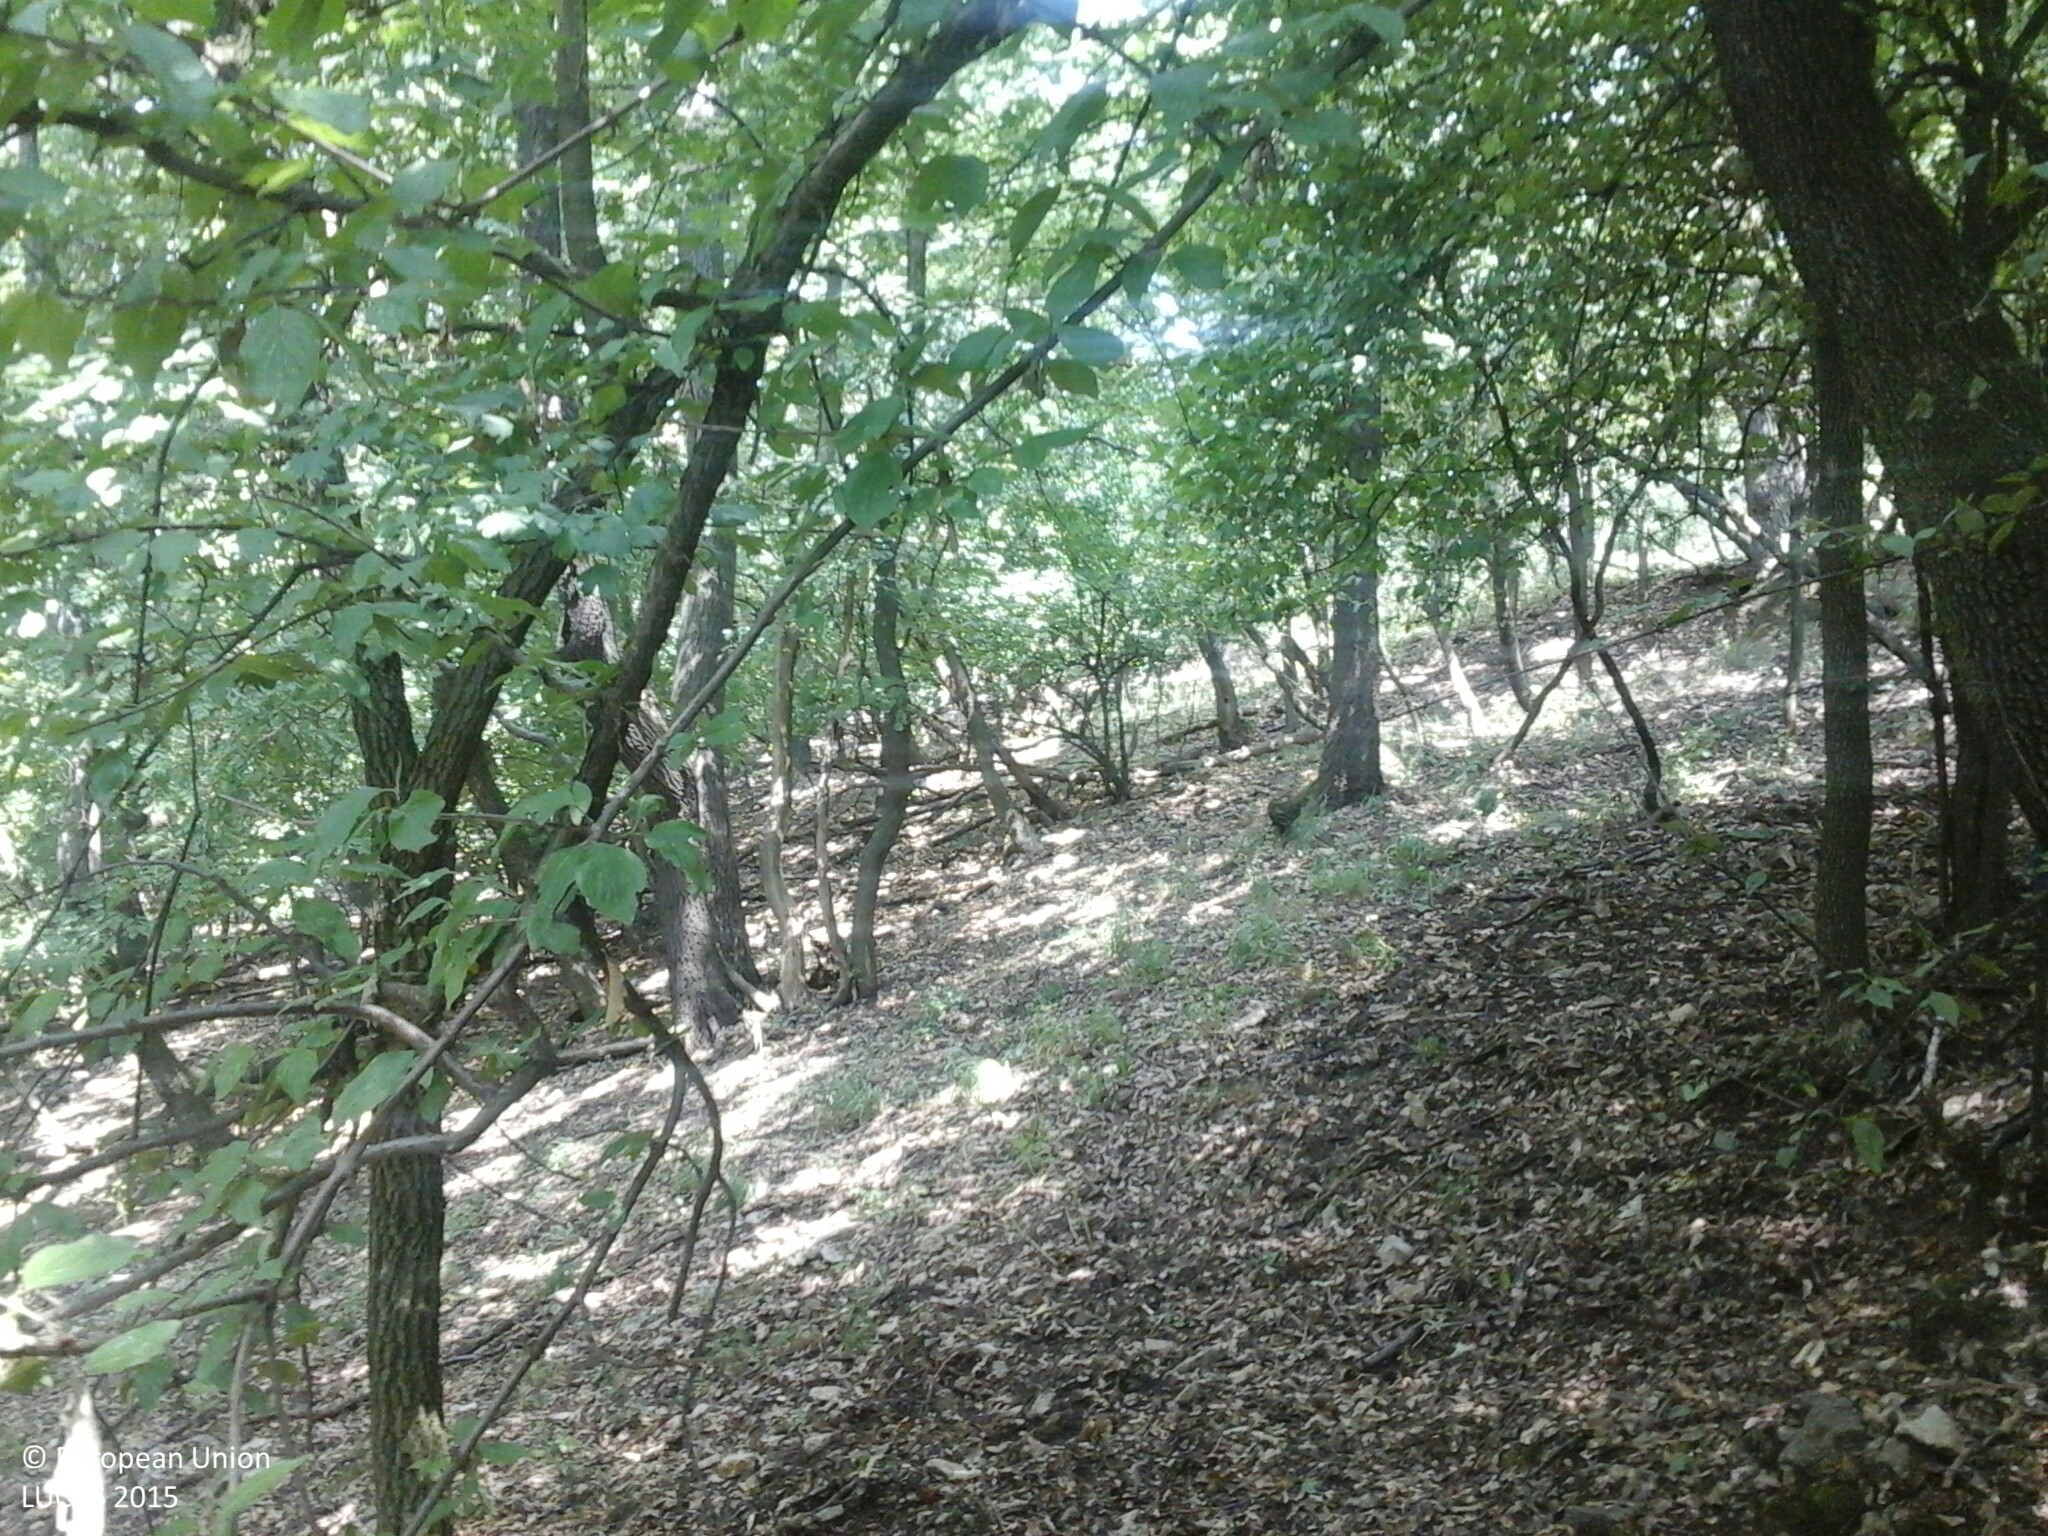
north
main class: Woodland
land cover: Broadleaved woodland
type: acidophilous oak and oak-birch forest
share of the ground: > 75 %
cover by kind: broadleaved forest trees 95 %, herbaceous plants 5 %
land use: Forestry
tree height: > 5 m
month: August
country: HU
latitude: 47.4537
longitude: 18.3556
